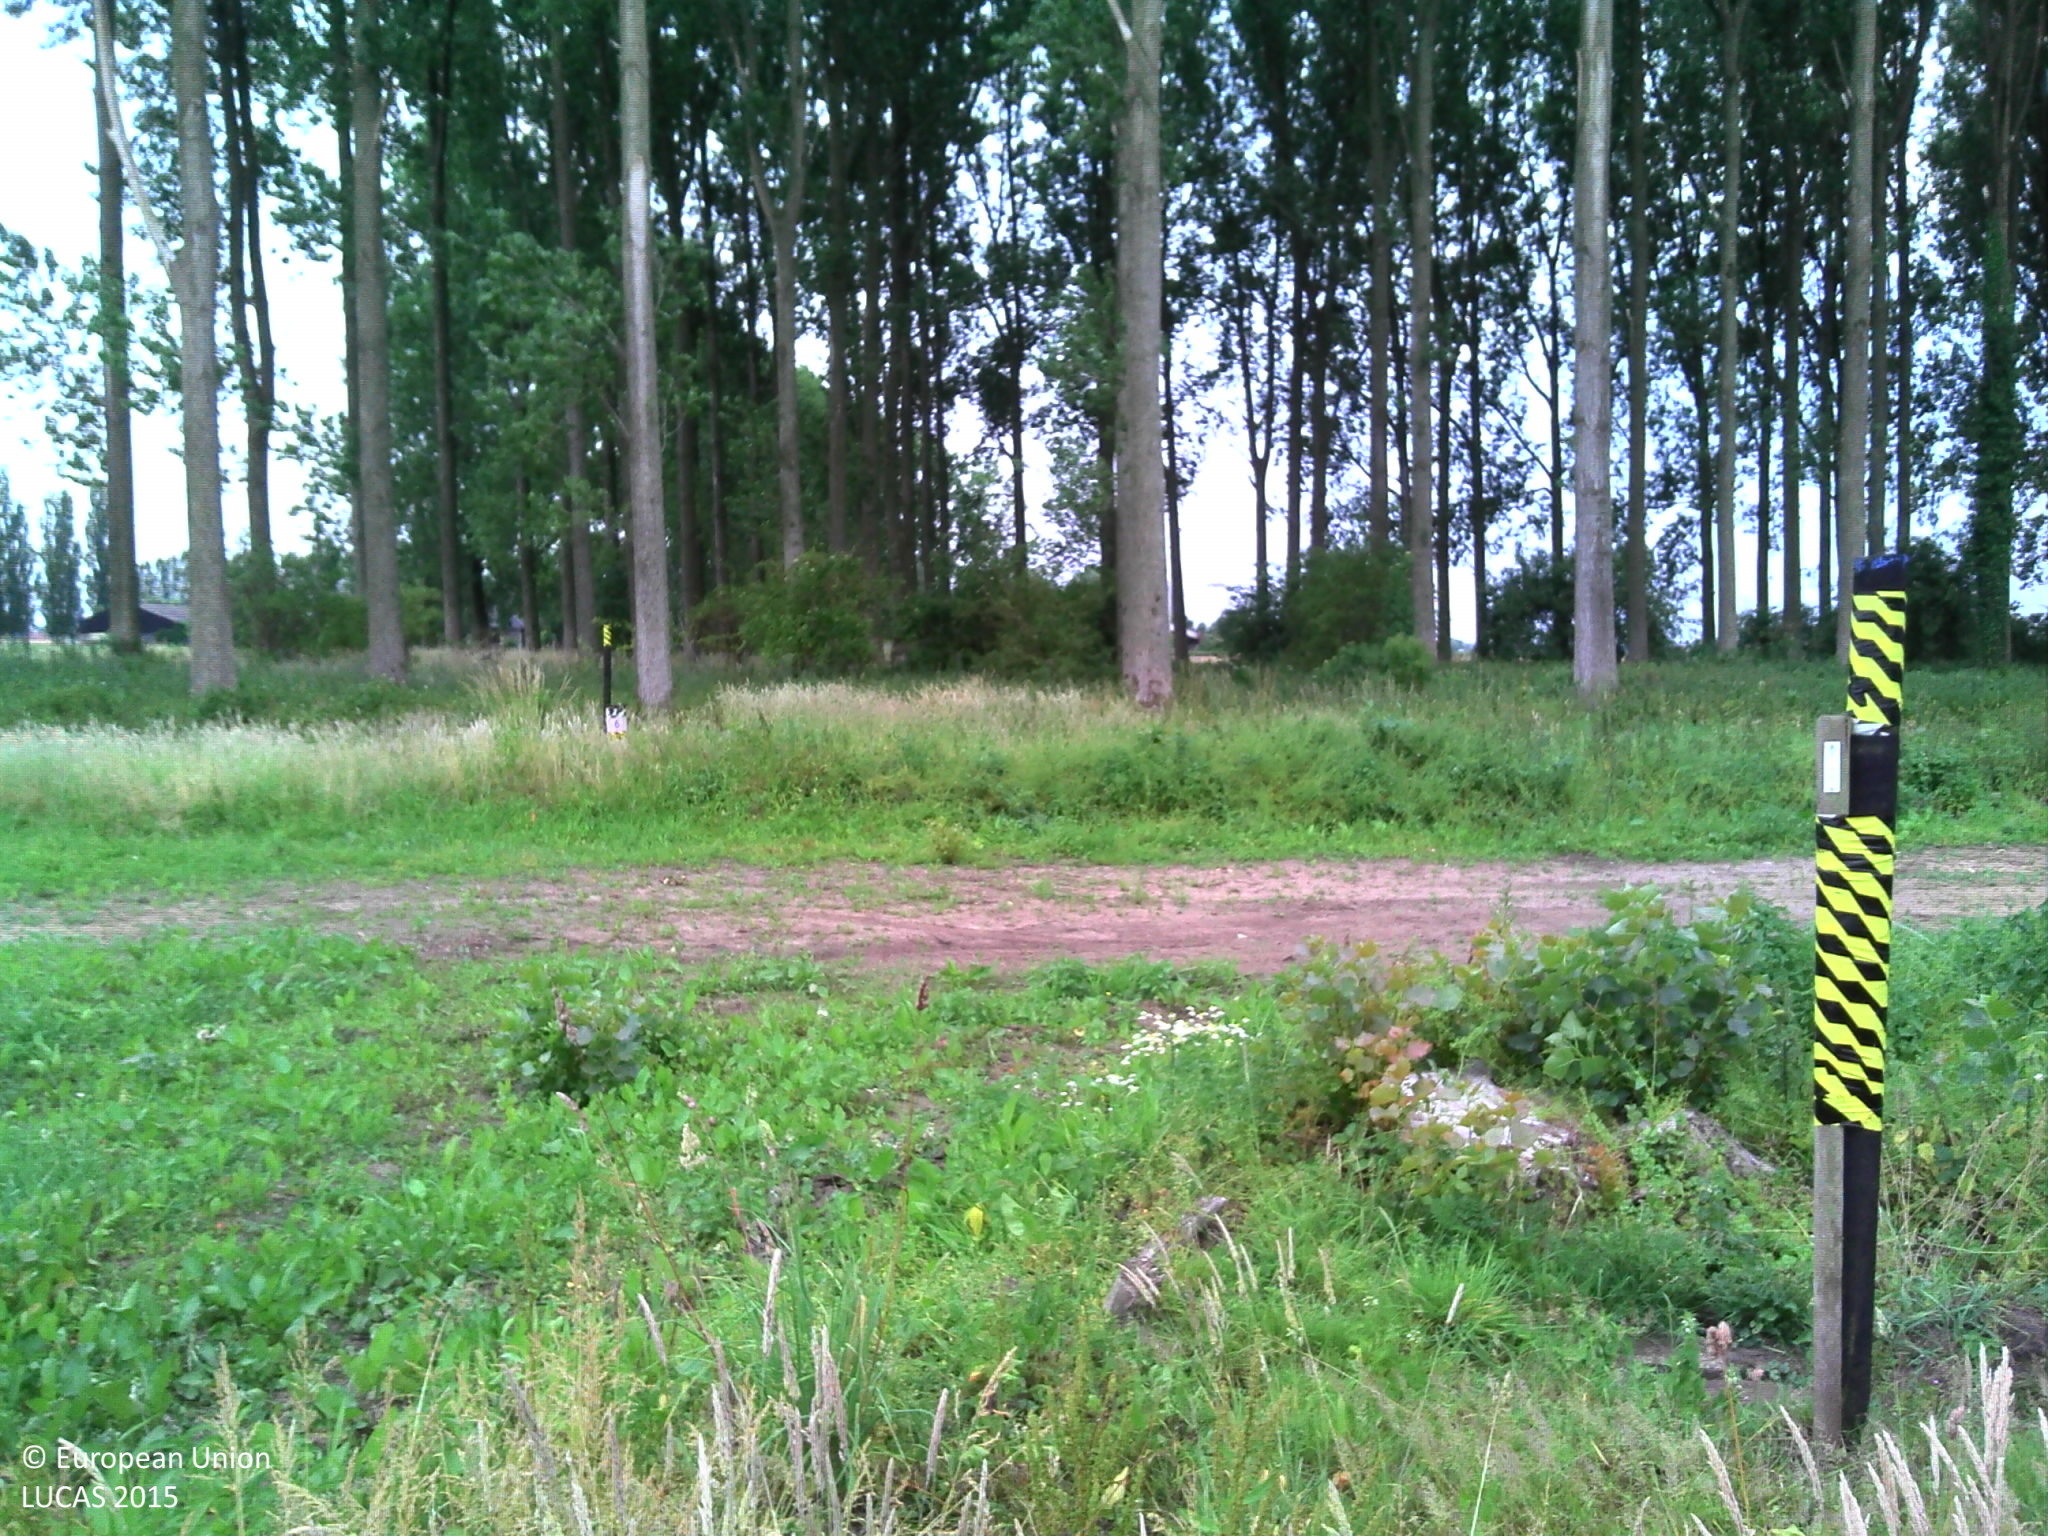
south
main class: Grassland
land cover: Spontaneously vegetated surfaces
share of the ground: > 75 %
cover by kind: herbaceous plants 100 %
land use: Forestry
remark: Clear cut
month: July
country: BE
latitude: 51.2126
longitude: 3.5936
